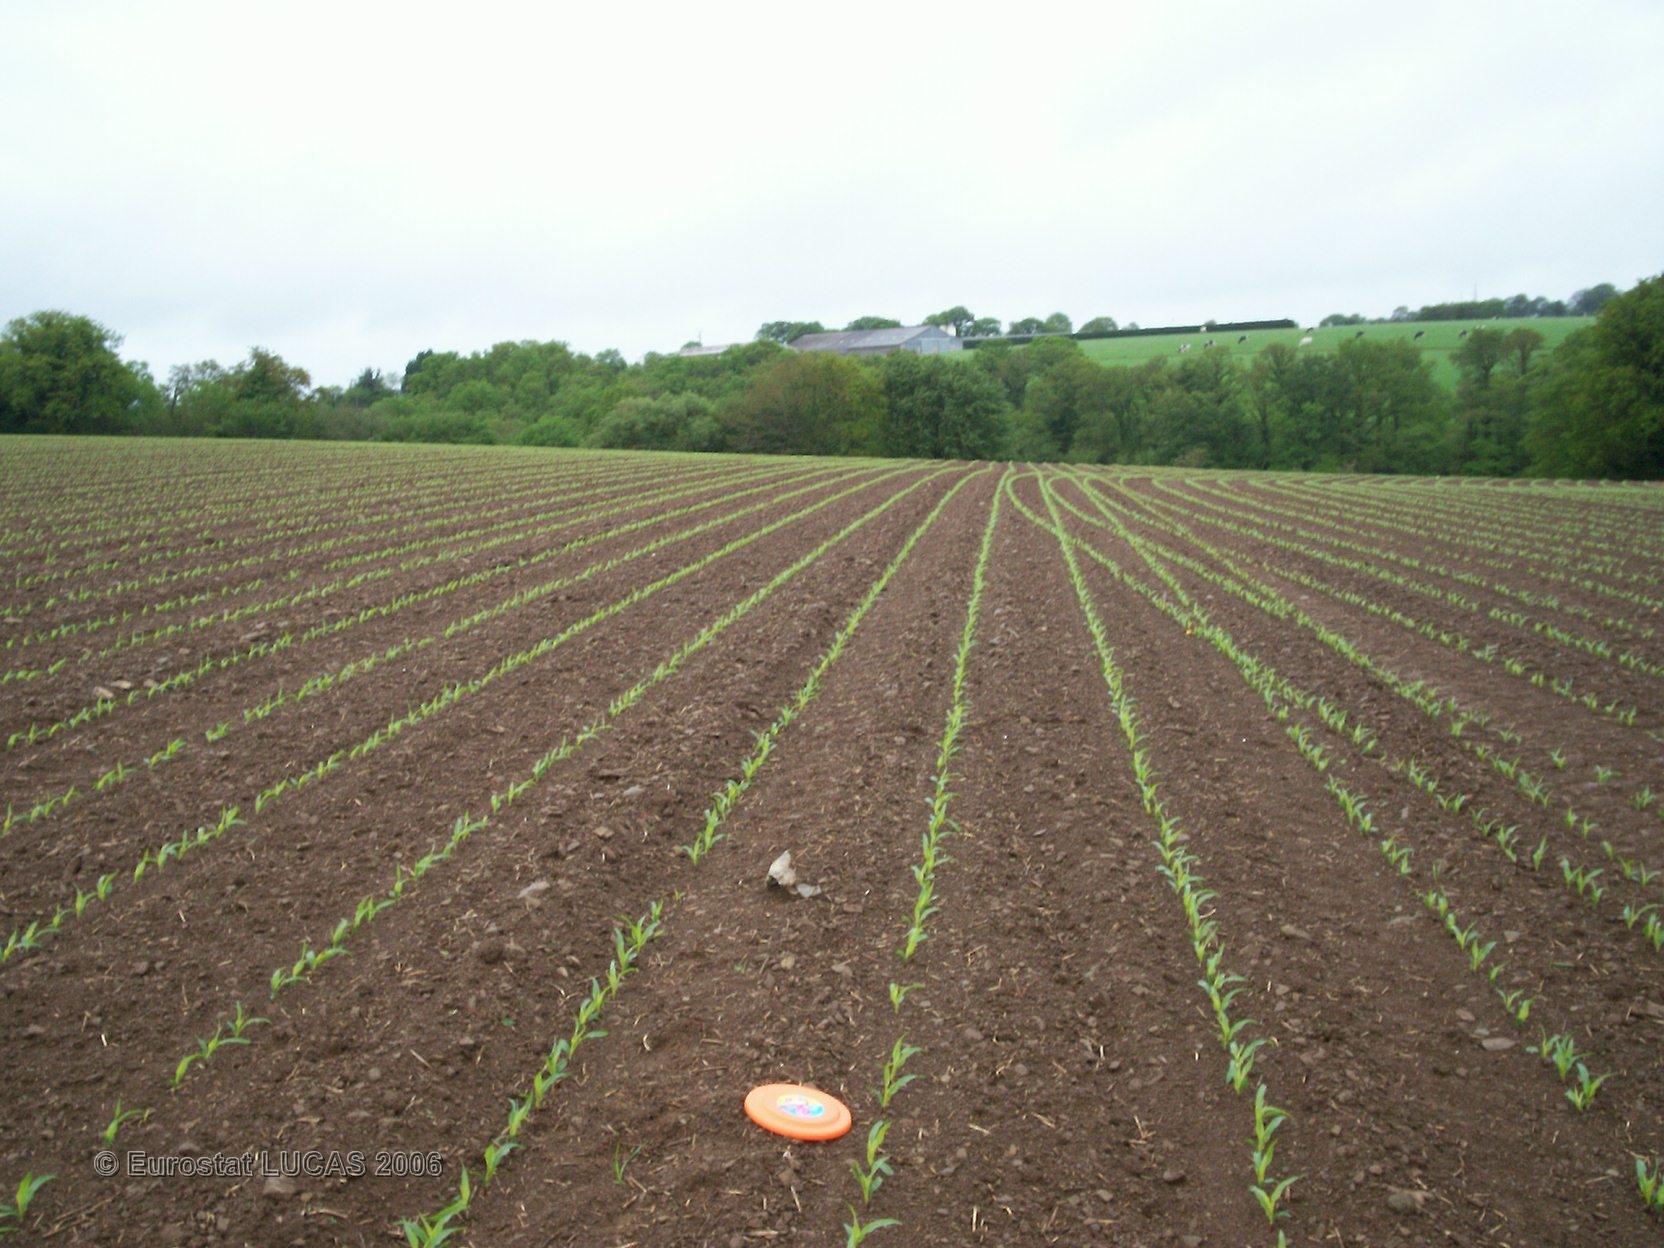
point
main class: Cropland
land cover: Maize
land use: Agriculture (excluding fallow land and kitchen gardens)
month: May
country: FR
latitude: 48.2994
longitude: -3.6560
